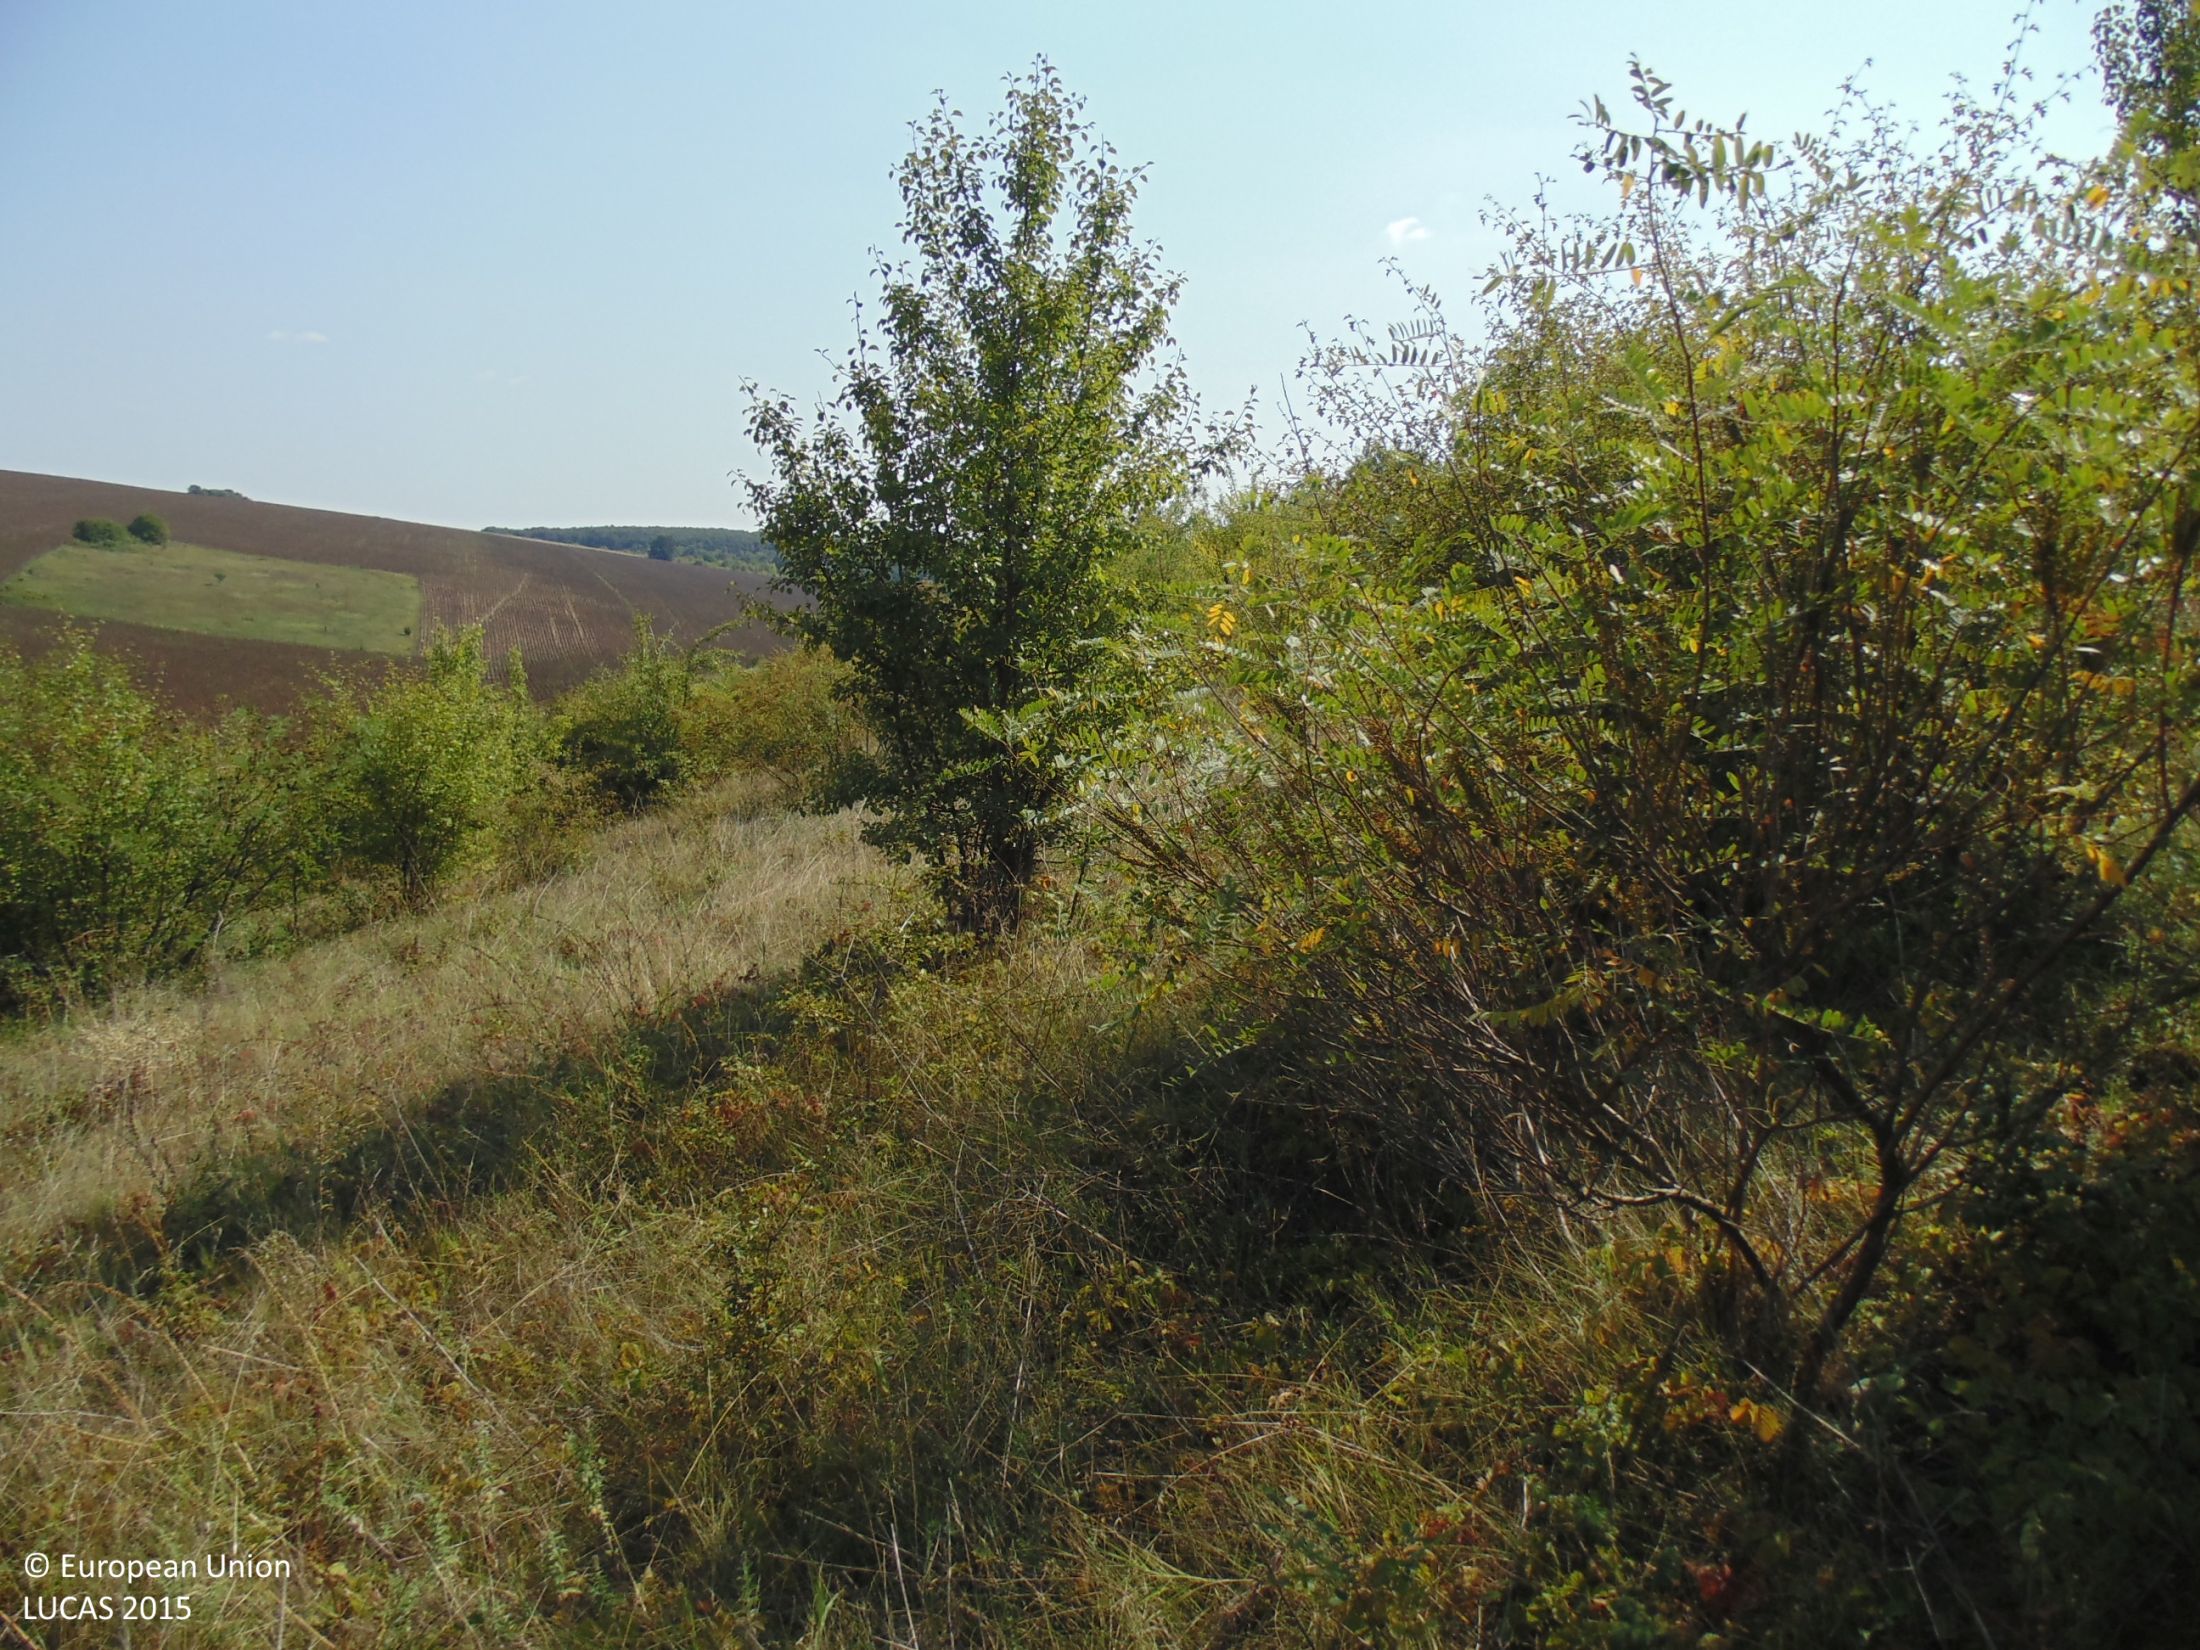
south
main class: Grassland
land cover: Grassland with sparse tree/shrub cover
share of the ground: > 75 %
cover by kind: herbaceous plants 90 %, broadleaved forest trees 5 %, shrubs 5 %
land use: Abandoned areas
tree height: < 5 m
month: August
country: BG
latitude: 43.9588
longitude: 27.3682
